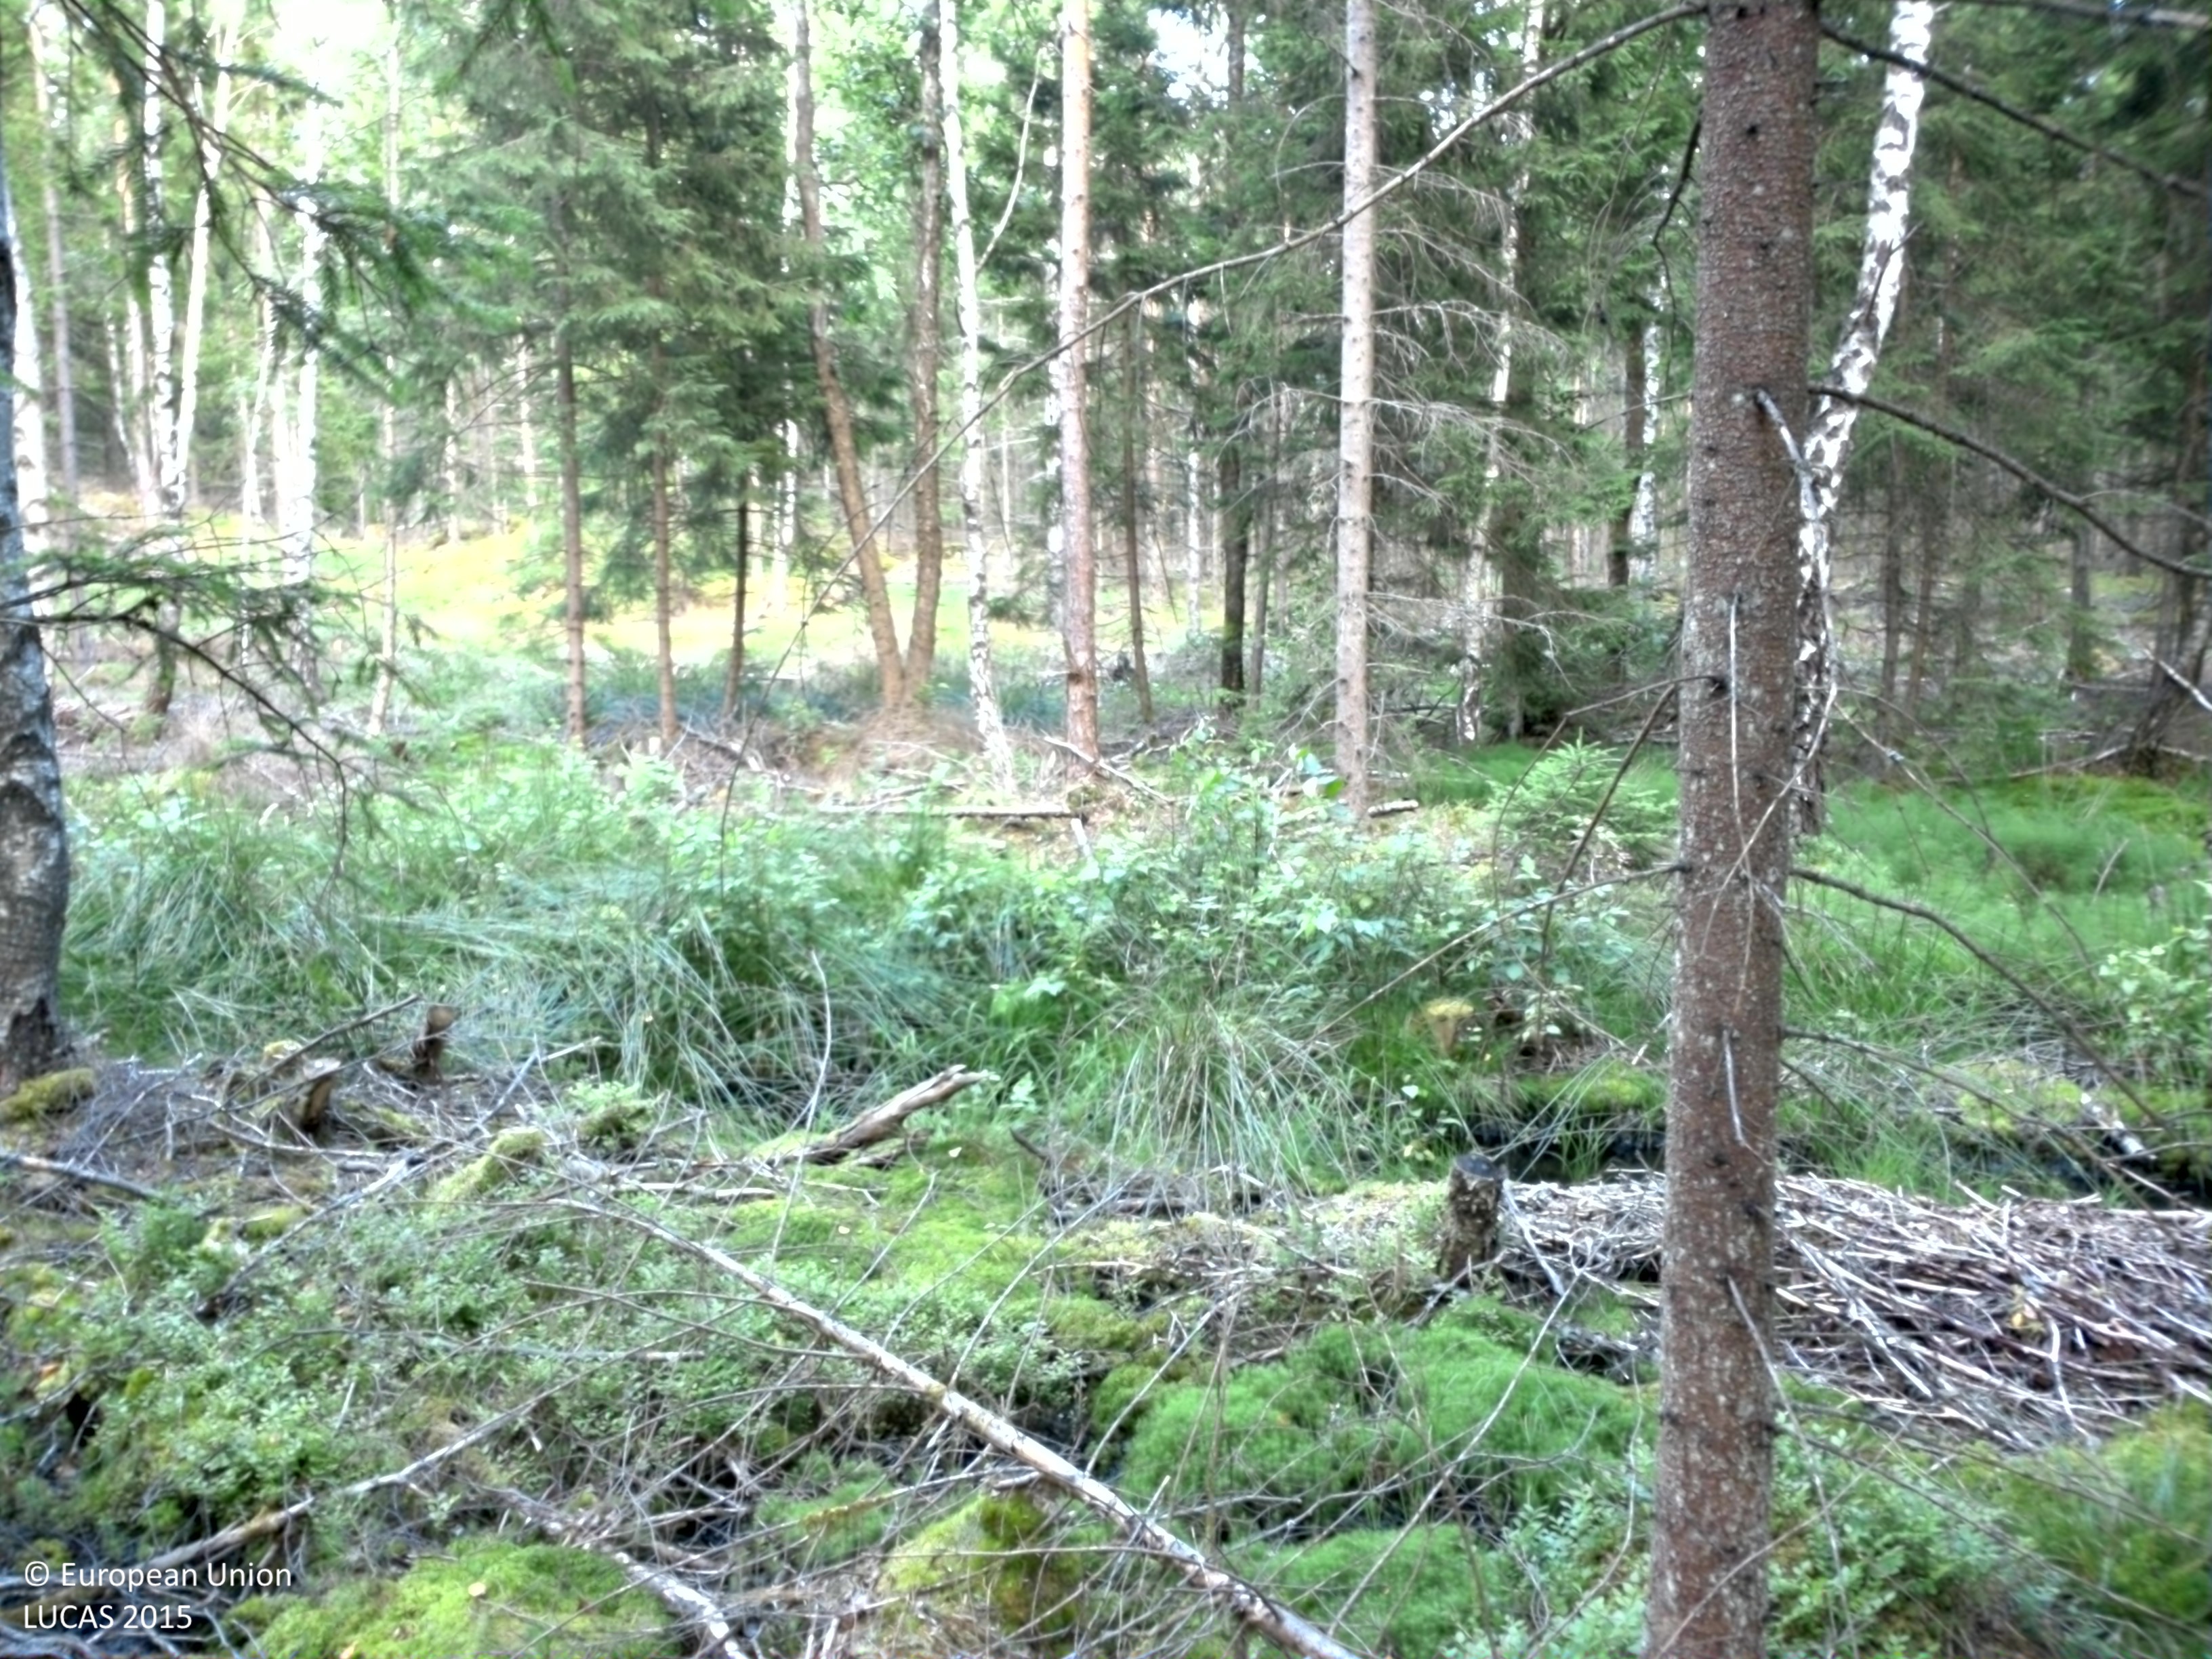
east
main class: Woodland
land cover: Spruce dominated coniferous woodland
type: boreal forest
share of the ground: 25 - 50 %
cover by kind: coniferous forest trees 45 %, lichens and mosses 35 %, broadleaved forest trees 10 %, herbaceous plants 10 %
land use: Forestry
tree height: > 5 m
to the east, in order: Spruce dominated coniferous woodland; Shruby margins; Paved roads, cycling and walking lanes; Shruby margins; Pine dominated coniferous woodland; Spruce dominated mixed woodland
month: July
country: SE
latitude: 56.3907
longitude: 14.6793
